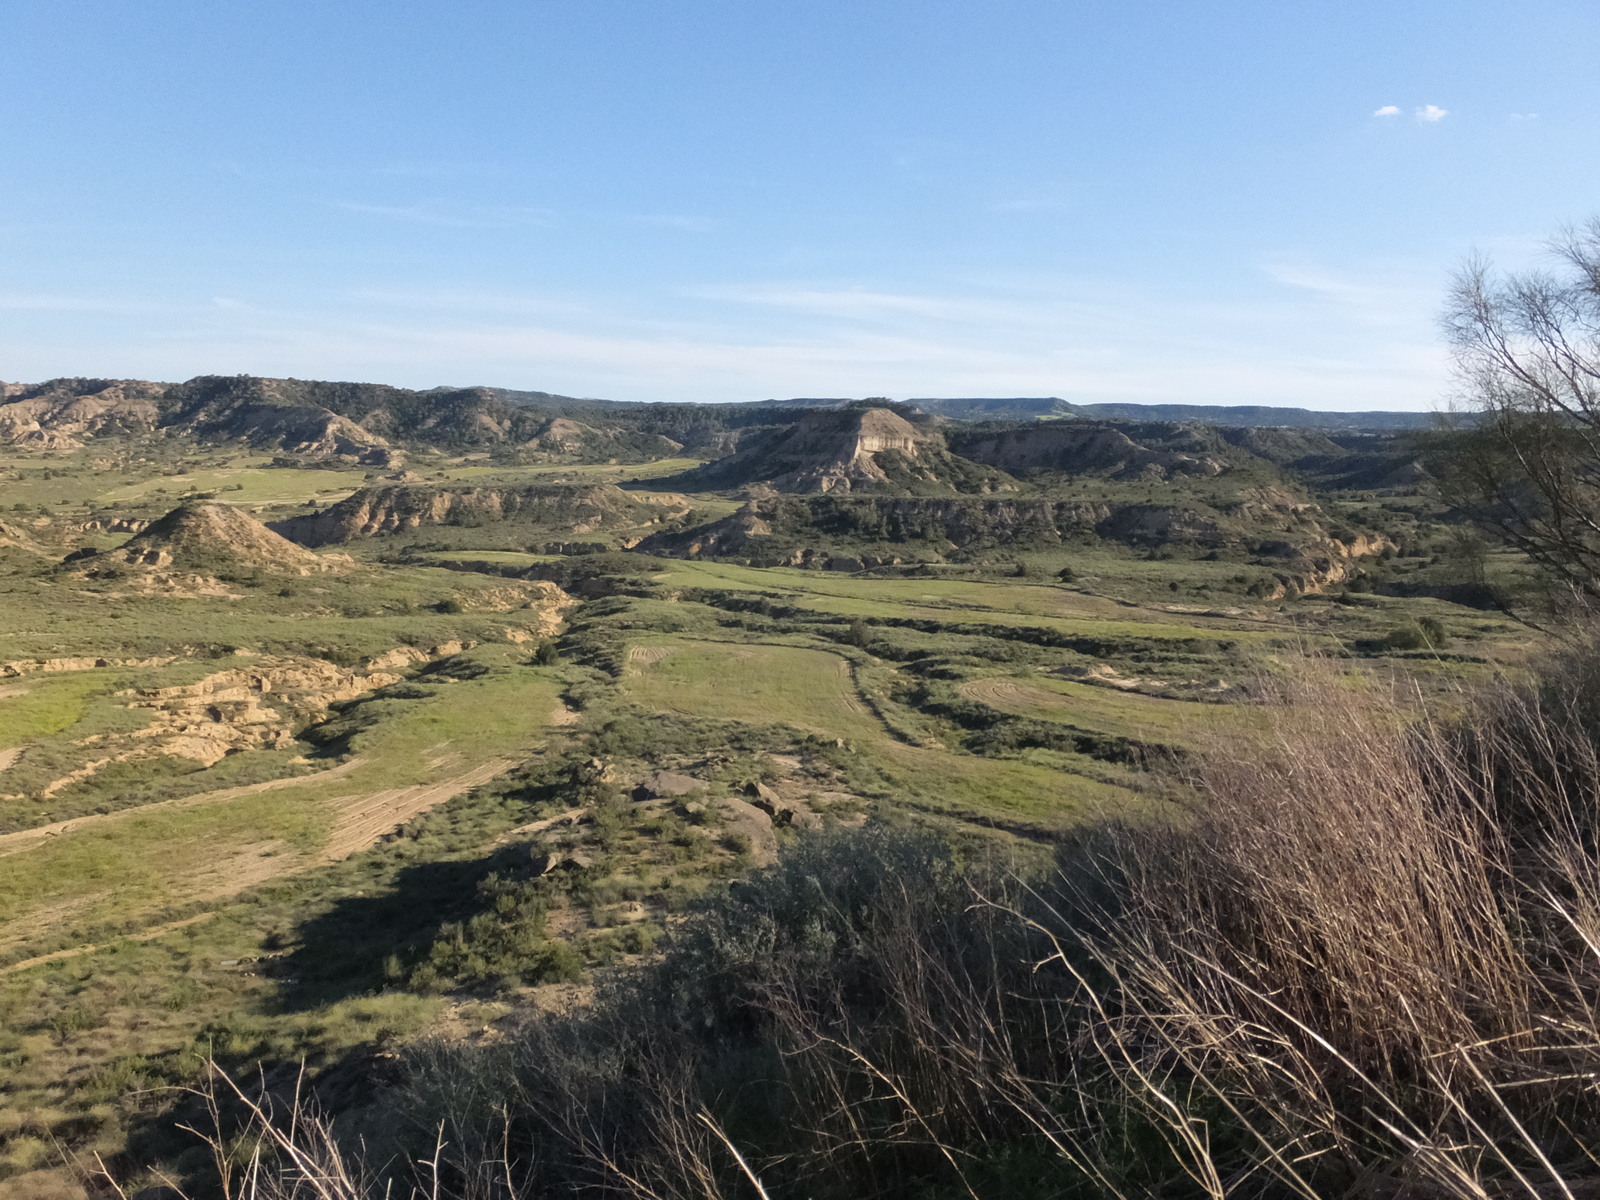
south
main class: Grassland
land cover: Grassland with sparse tree/shrub cover
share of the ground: > 75 %
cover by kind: herbaceous plants 90 %, coniferous forest trees 5 %, shrubs 5 %
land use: Semi-natural and natural areas not in use
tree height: < 5 m
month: April
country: ES
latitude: 41.7016
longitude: -0.1957
